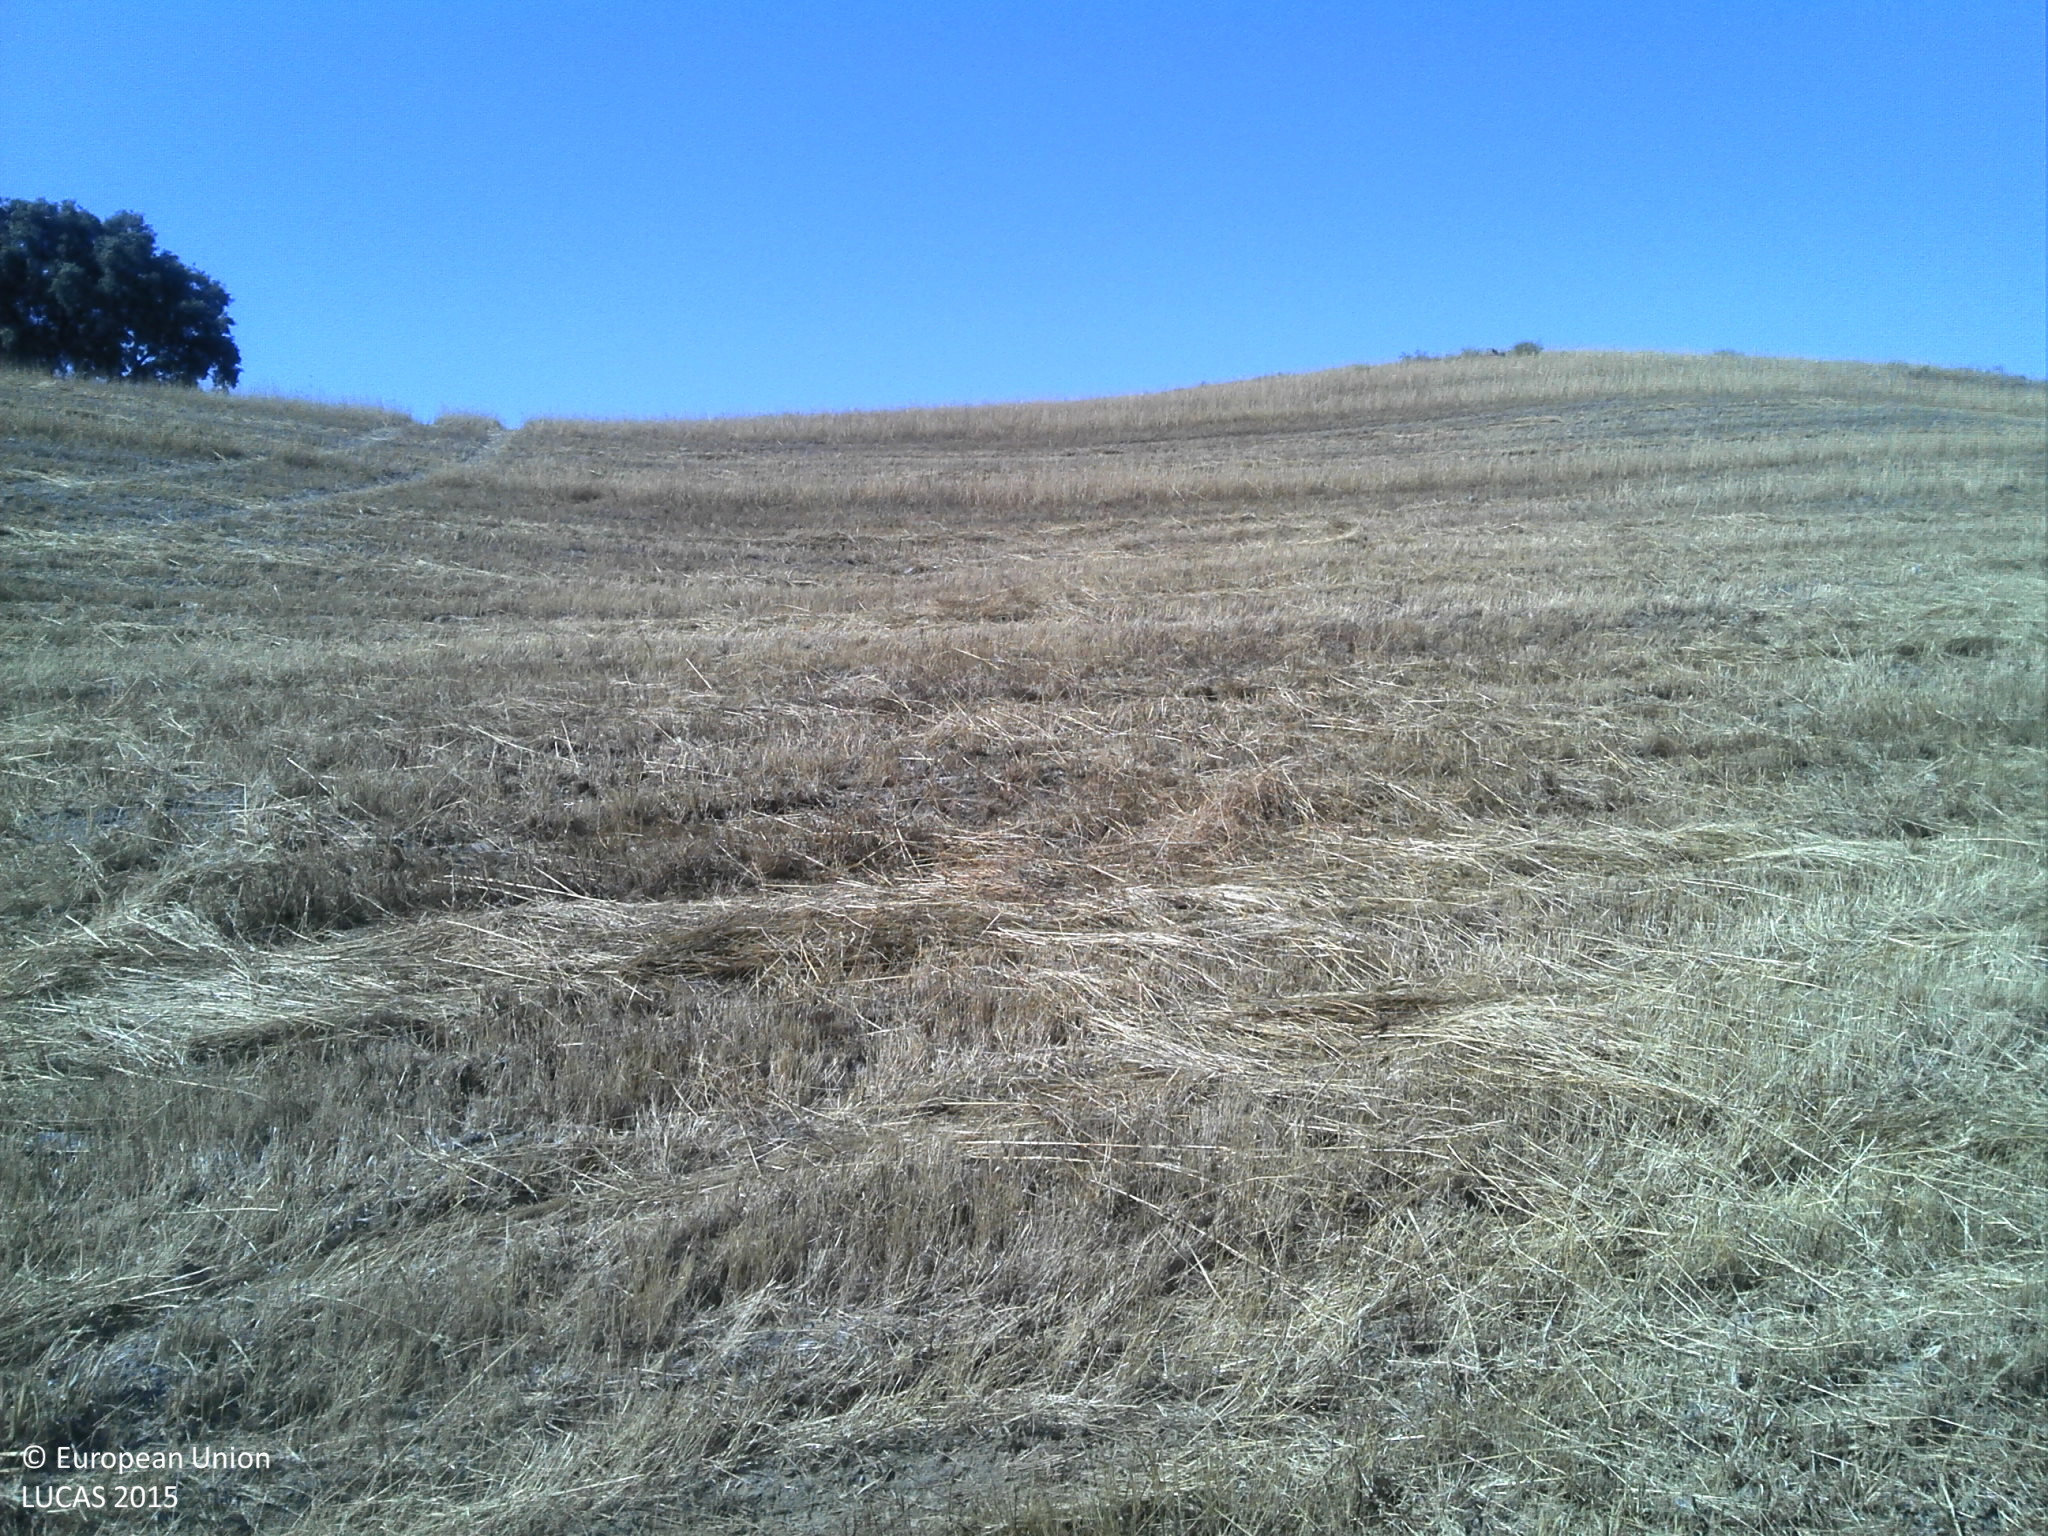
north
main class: Cropland
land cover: Temporary grasslands
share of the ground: 25 - 50 %
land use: Agriculture (excluding fallow land and kitchen gardens)
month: June
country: PT
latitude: 39.9970
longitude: -7.1596
